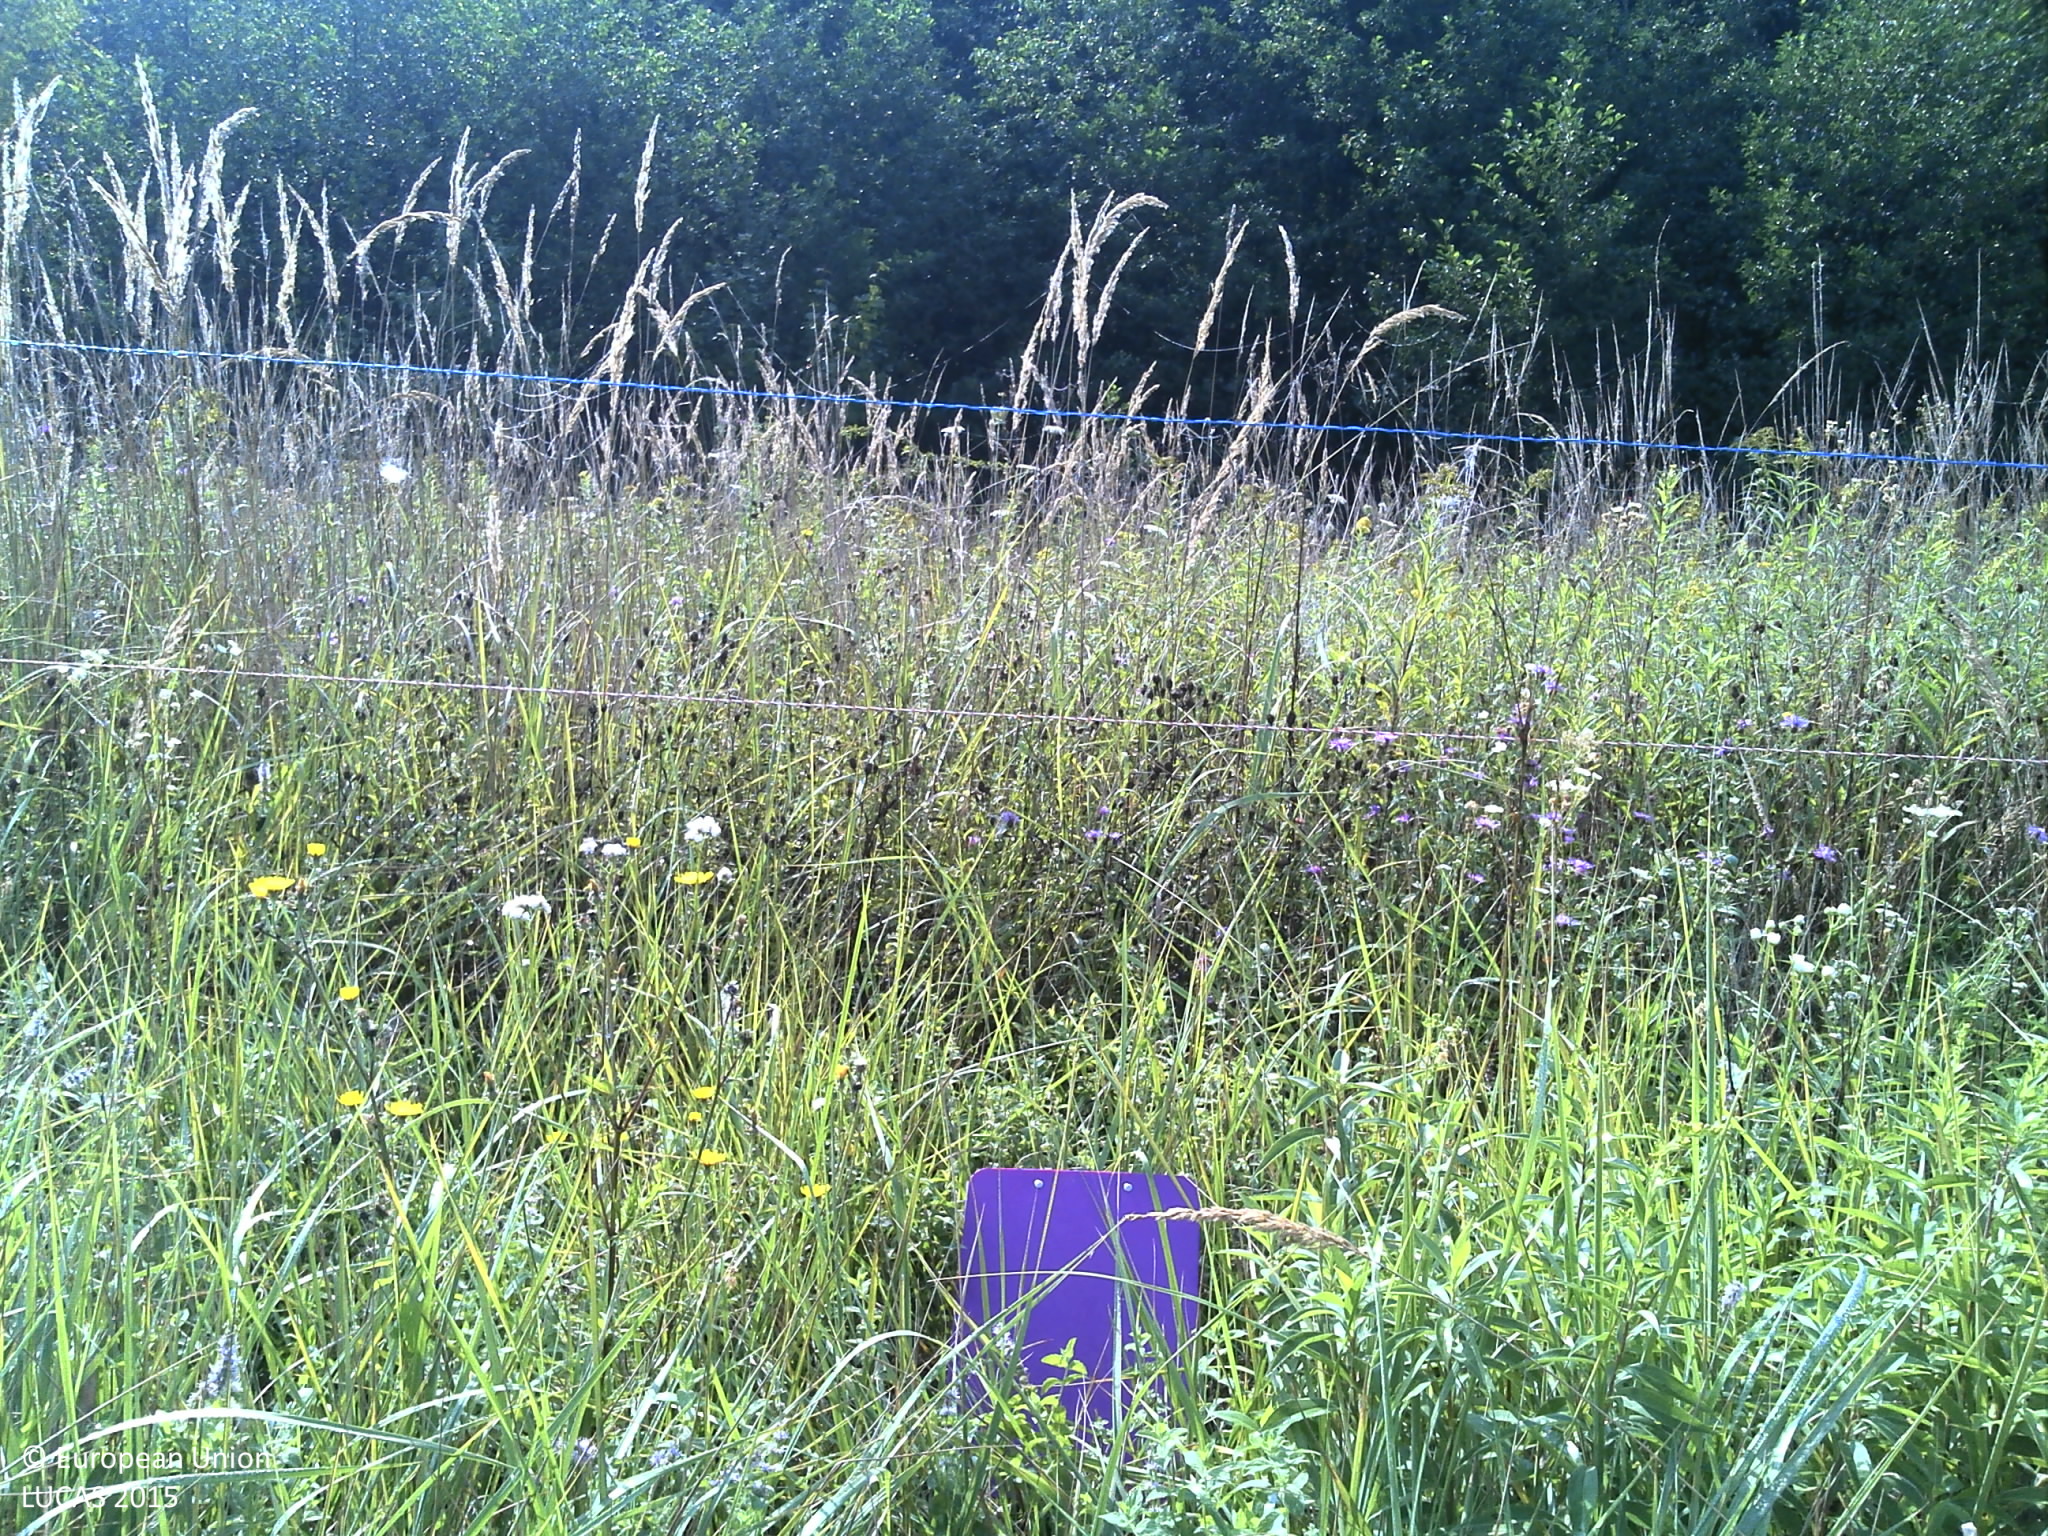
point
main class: Grassland
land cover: Spontaneously vegetated surfaces
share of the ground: > 75 %
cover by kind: herbaceous plants 100 %
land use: Semi-natural and natural areas not in use
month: August
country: HR
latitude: 45.1135
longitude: 16.3648
